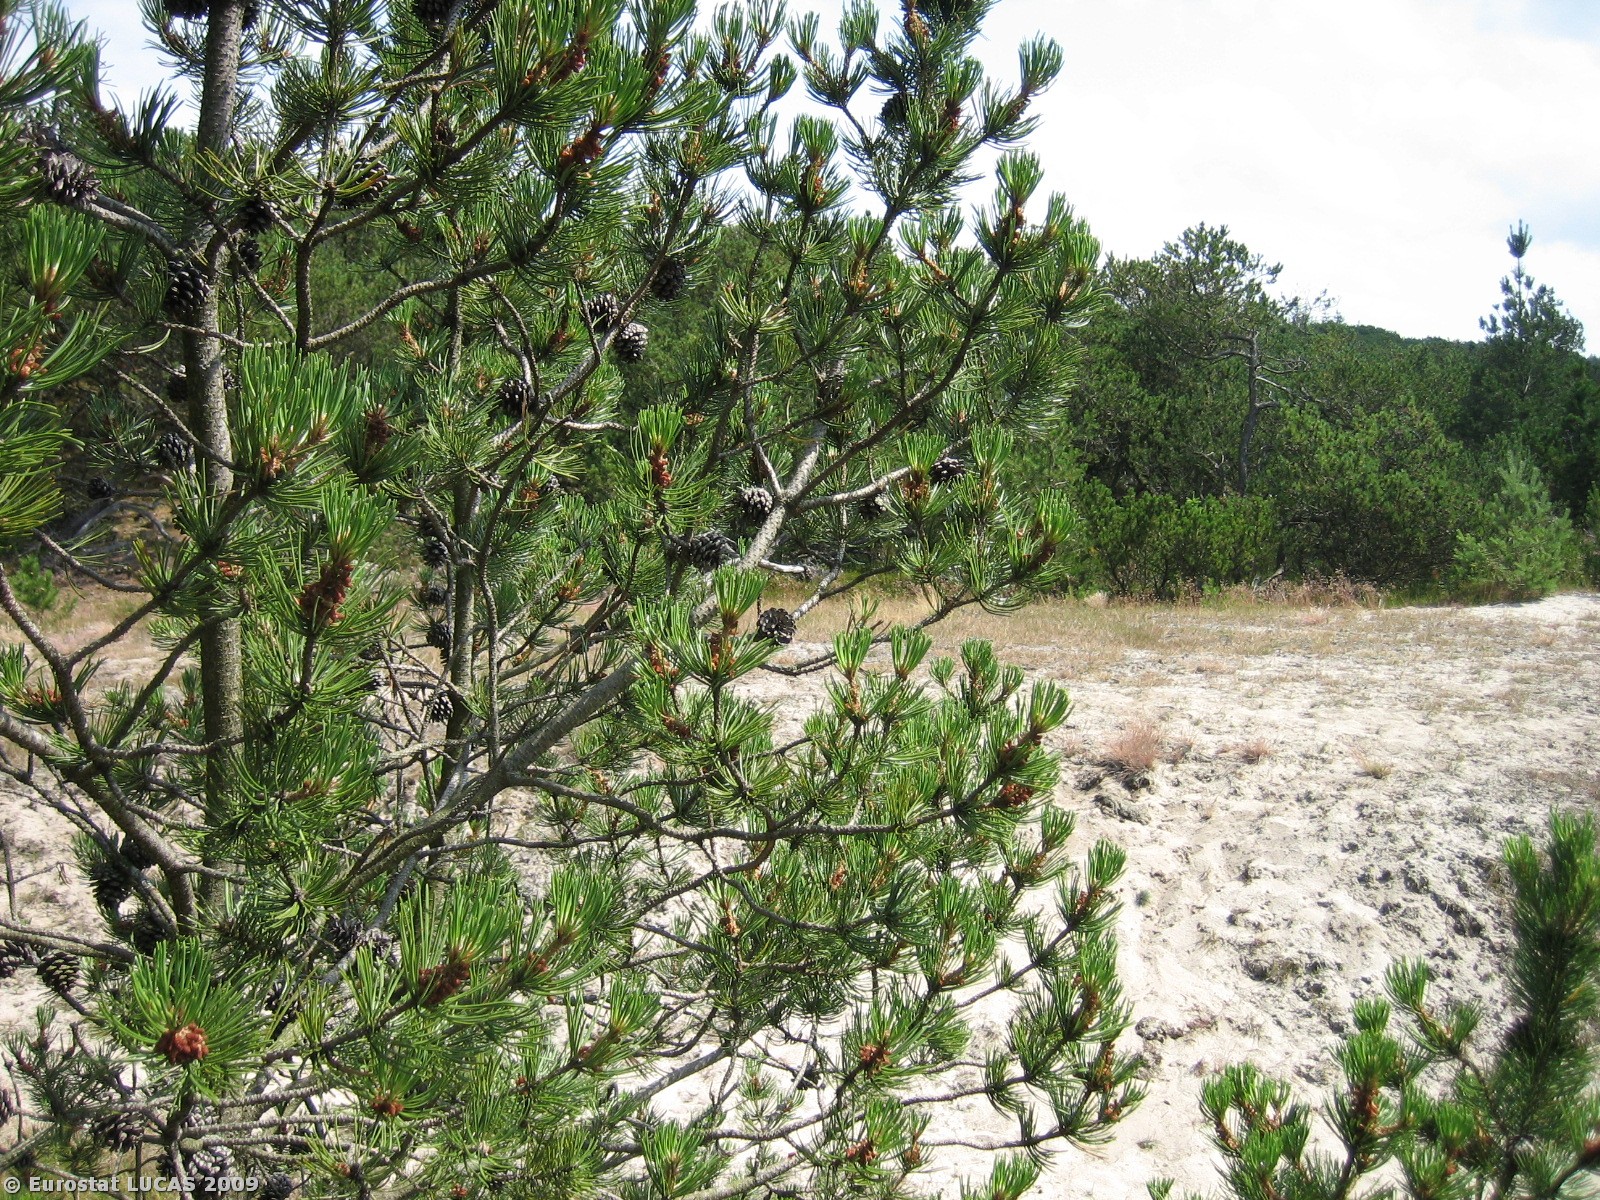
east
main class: Woodland
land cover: Coniferous woodland
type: hemiboreal forest and nemoral coniferous forest and mixed broadleaved-coniferous forest
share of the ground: 50 - 75 %
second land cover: Bare land
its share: 10 - 25 %
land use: Forestry
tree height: > 5 m
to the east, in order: Coniferous woodland; Bare land; Grass margins; Ditches and canals; Grass margins; Bare land; Grassland without tree/shrub cover; Coniferous woodland; Bare land; Tracks; Bare land; Coniferous woodland; Tracks; Grass margins; Grassland without tree/shrub cover
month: July
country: DK
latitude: 55.7621
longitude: 8.2327
